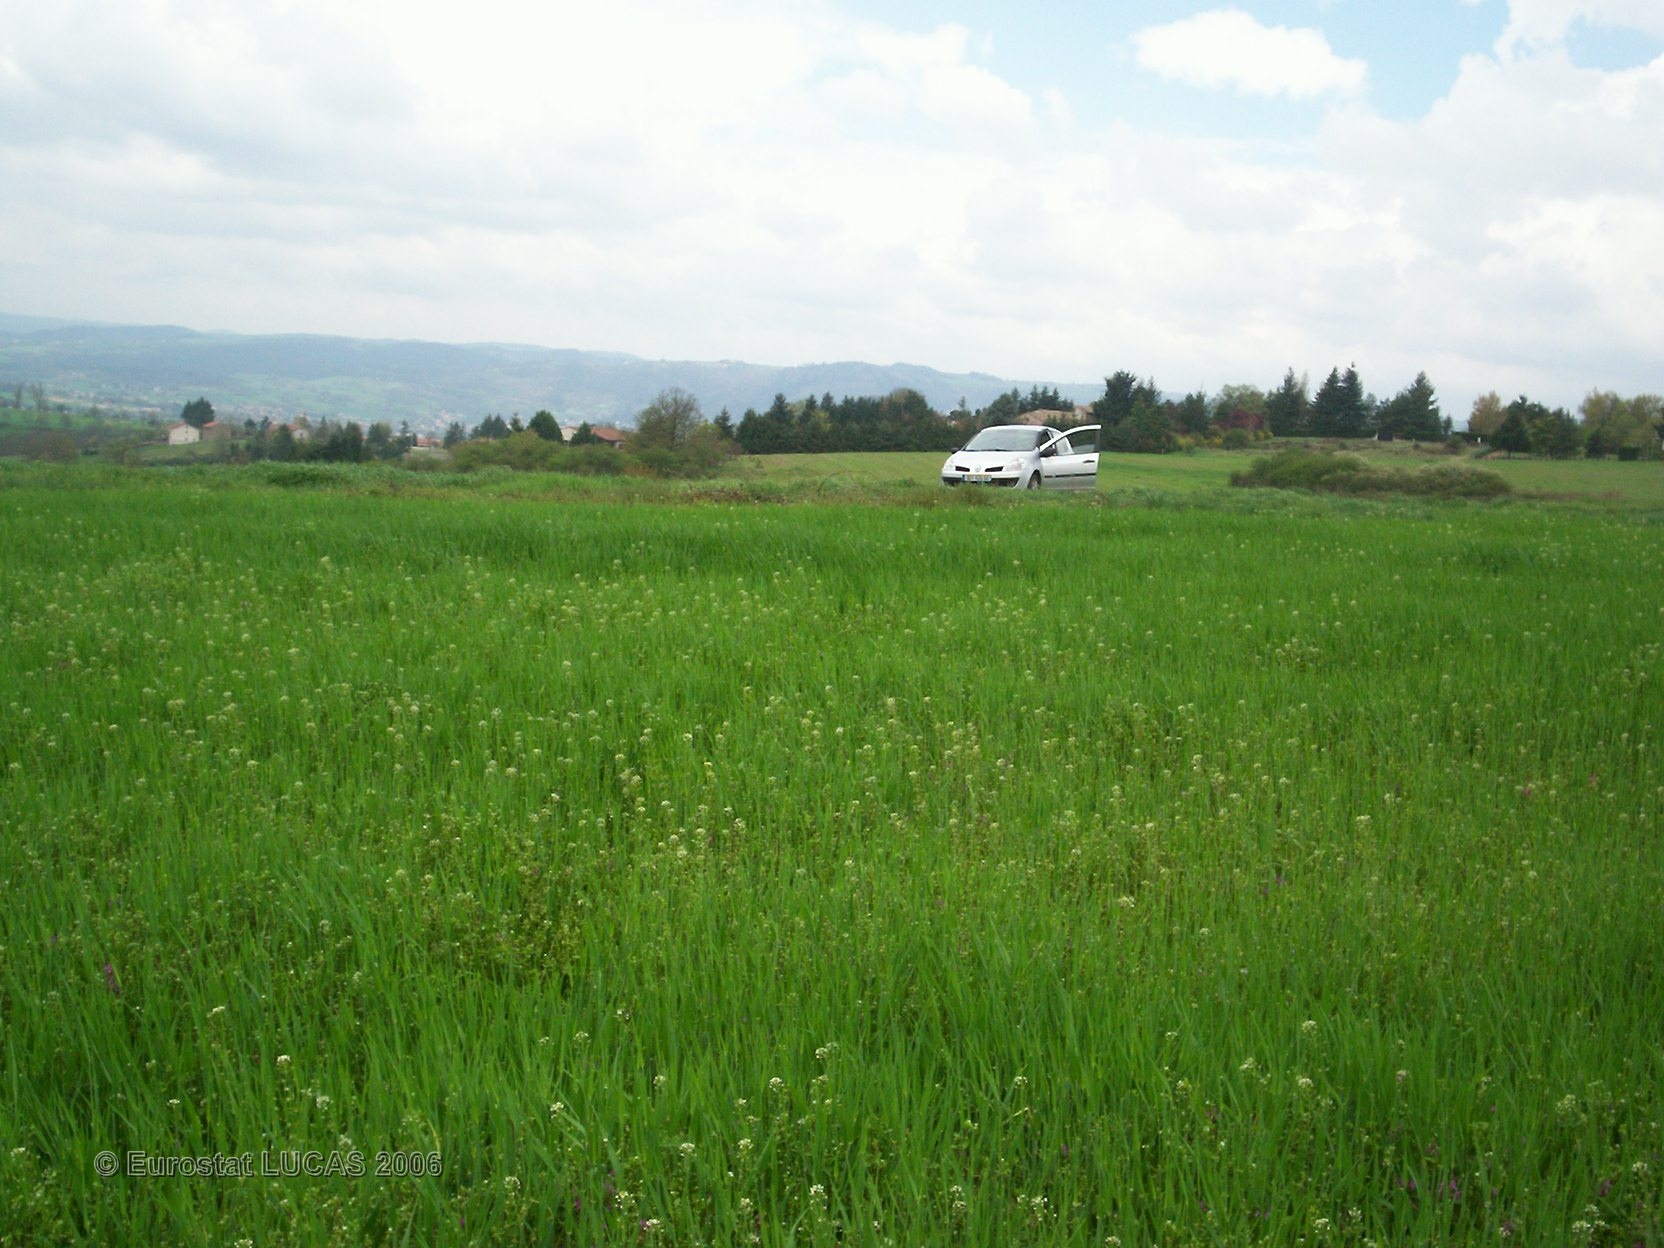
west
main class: Cropland
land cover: Barley
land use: Agriculture (excluding fallow land and kitchen gardens)
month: April
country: FR
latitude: 45.3075
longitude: 4.1752
